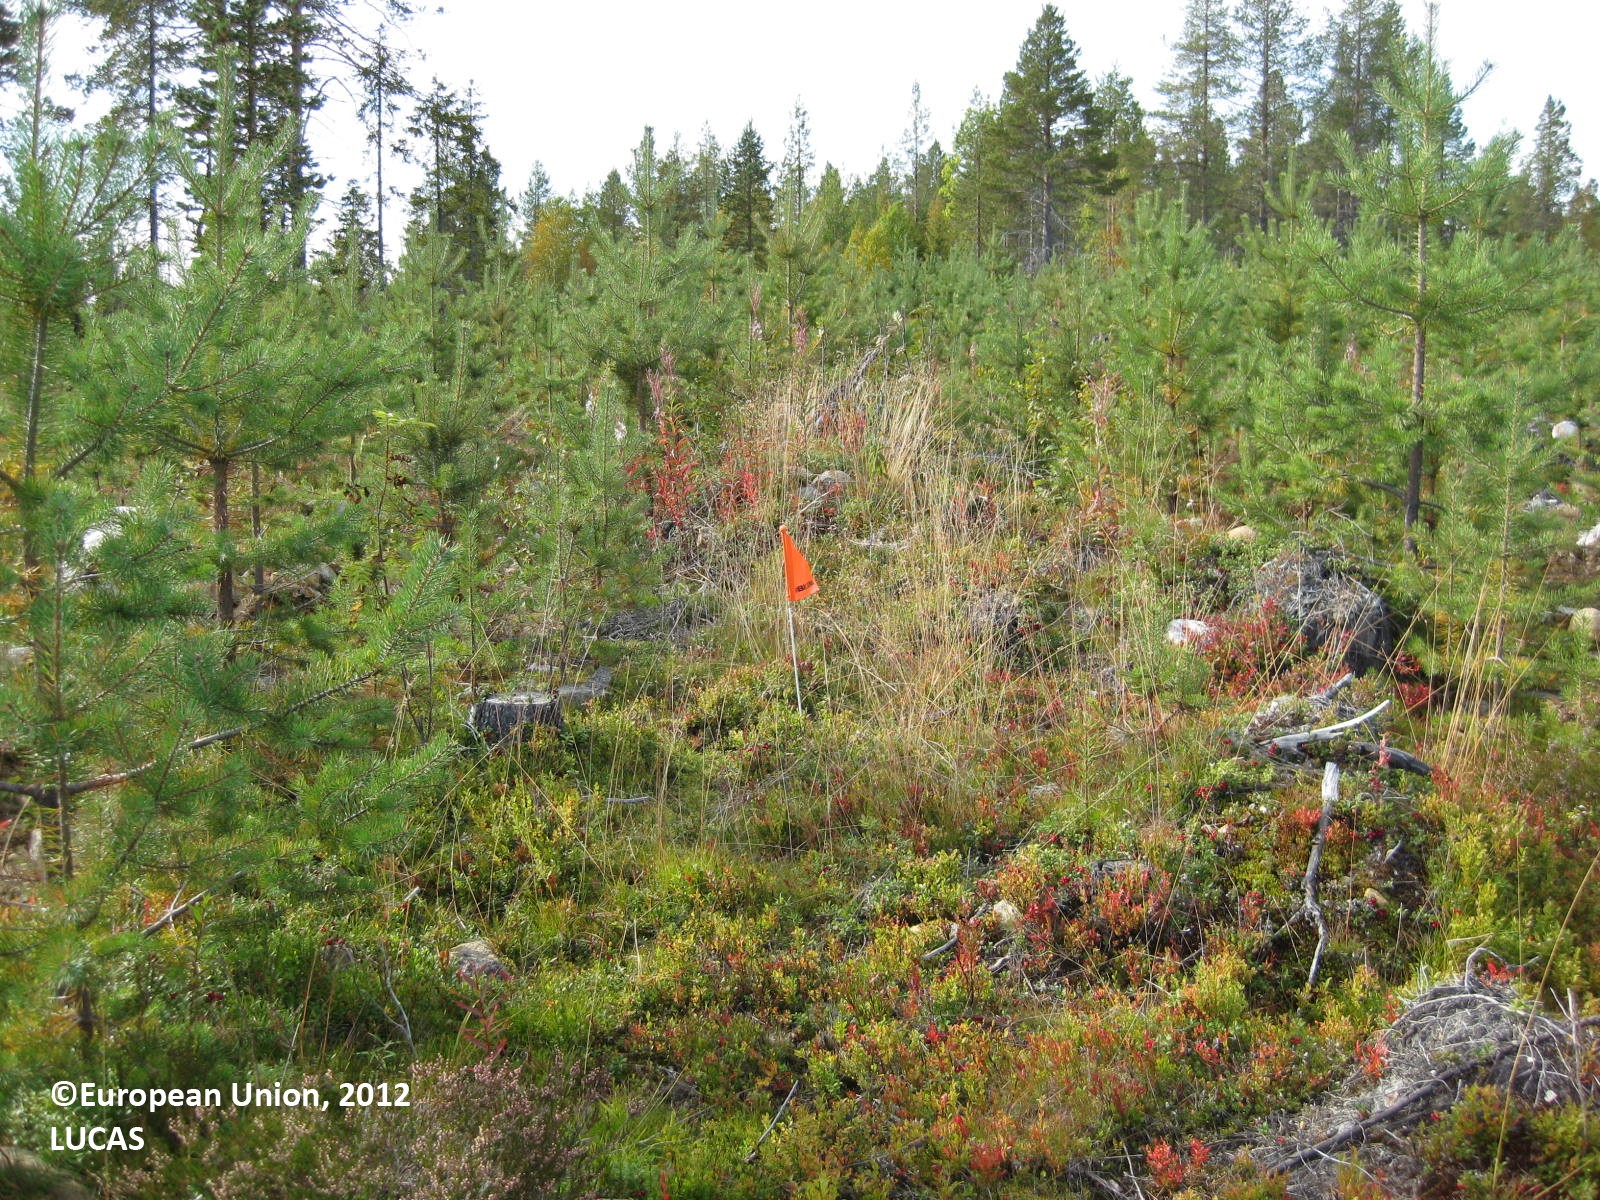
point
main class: Woodland
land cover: Pine dominated coniferous woodland
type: boreal forest
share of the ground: 50 - 75 %
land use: Forestry
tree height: < 5 m
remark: Clear cut
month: August
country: FI
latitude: 65.8890
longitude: 28.7002
